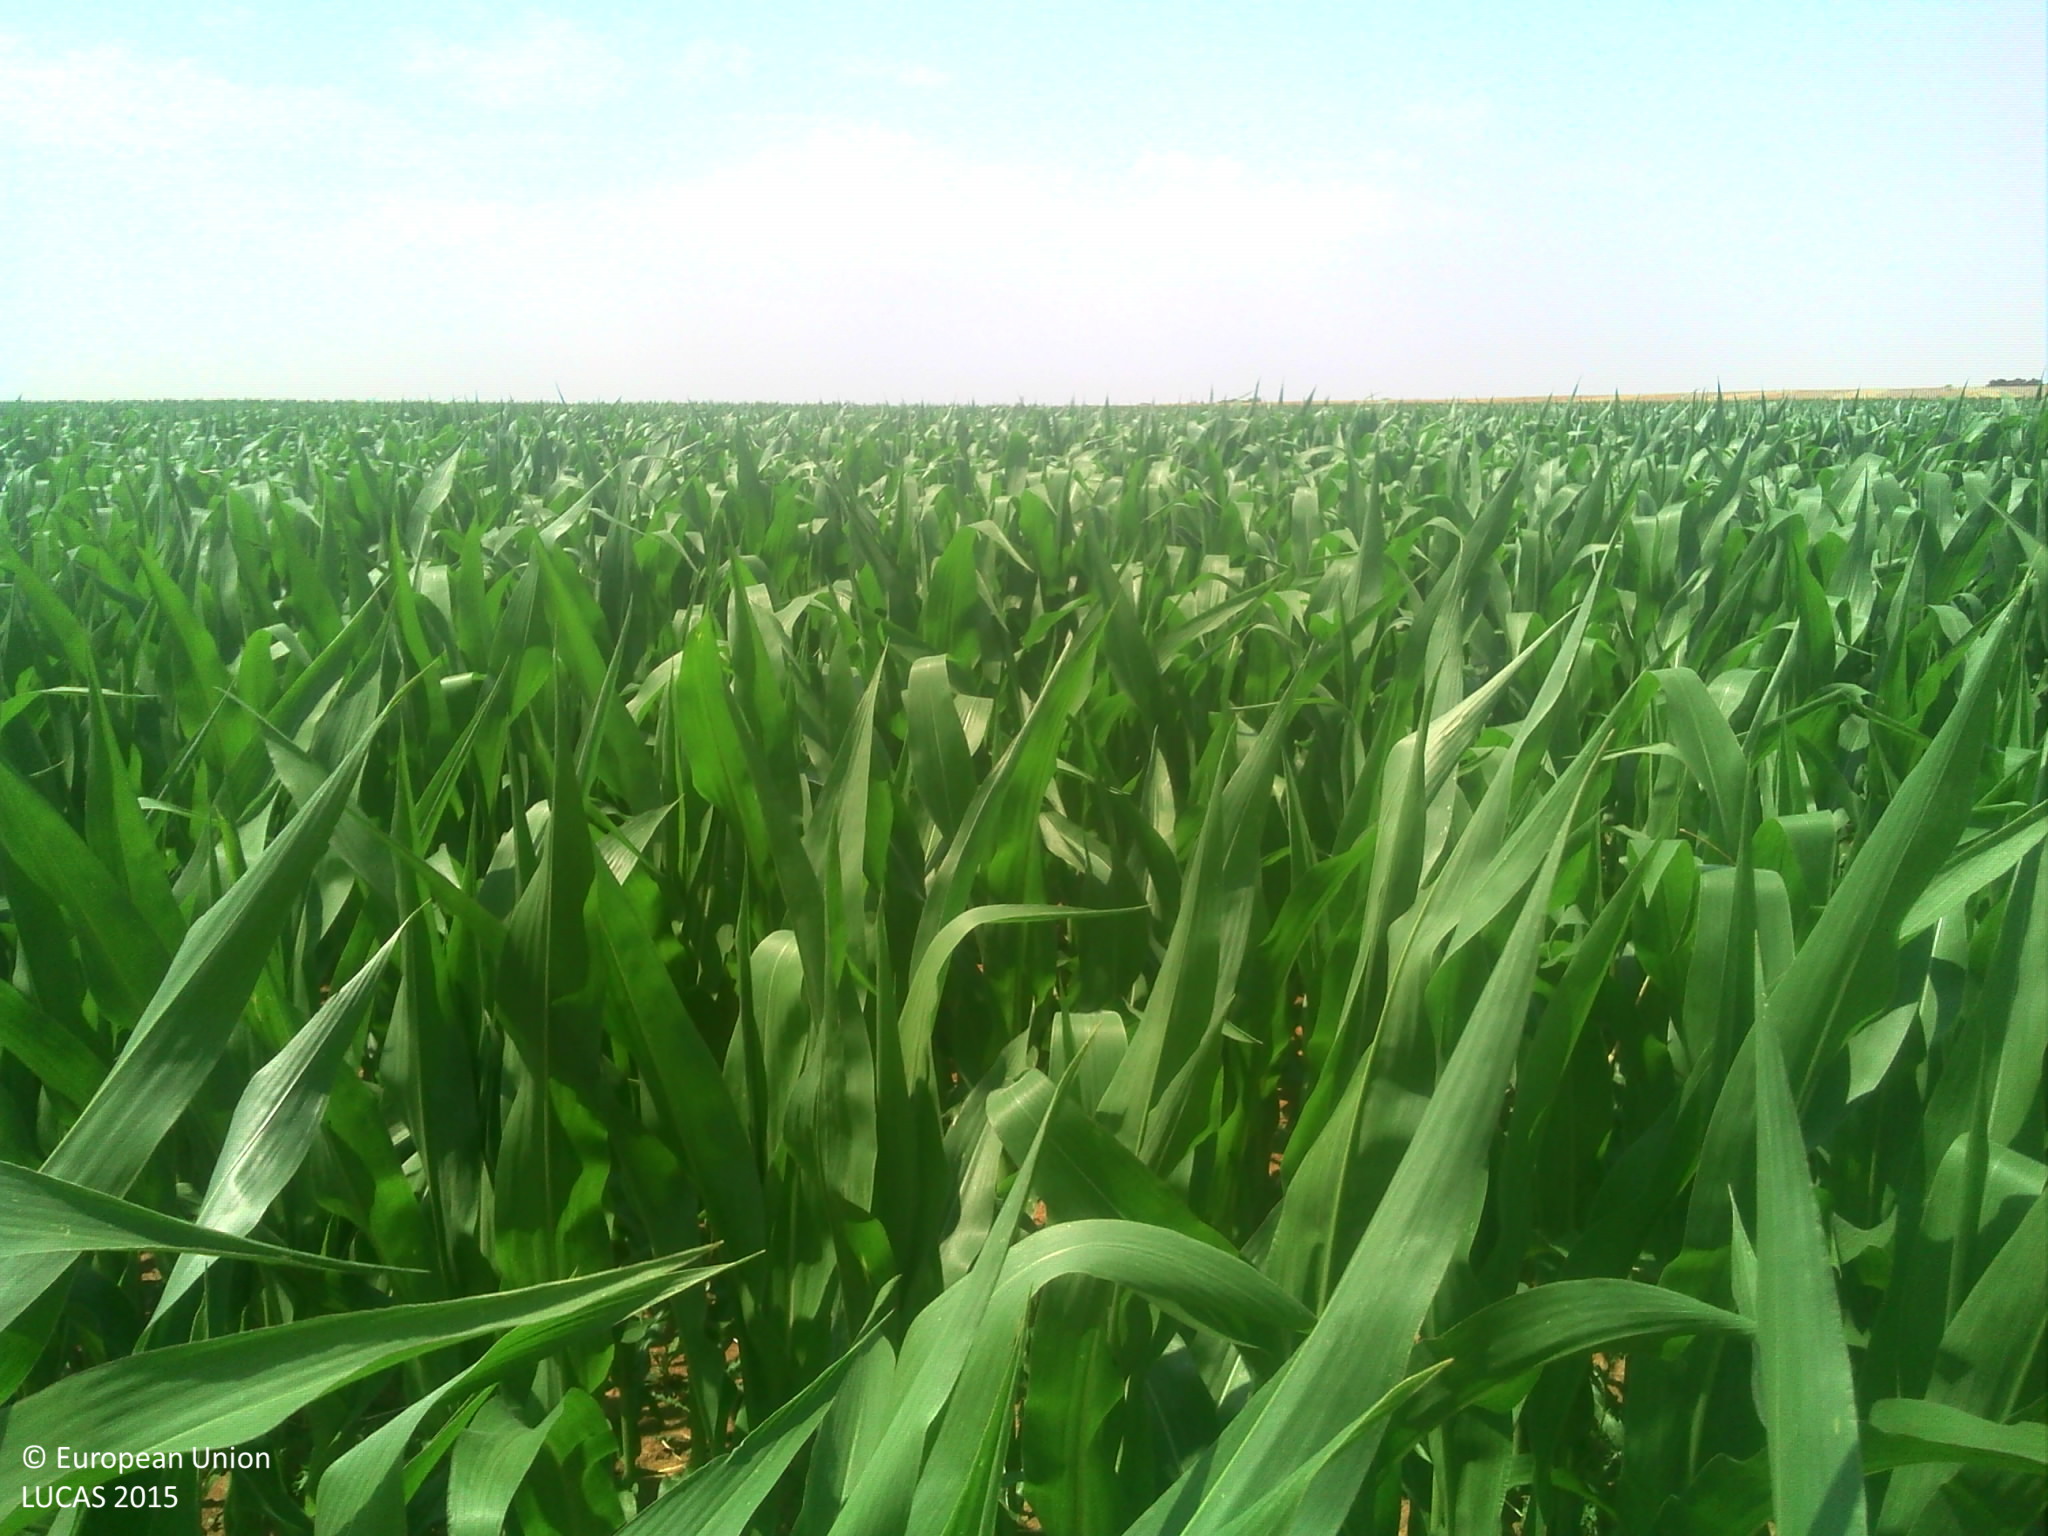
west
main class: Cropland
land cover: Maize
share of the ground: > 75 %
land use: Agriculture (excluding fallow land and kitchen gardens)
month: July
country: FR
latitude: 47.6673
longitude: 1.3683
